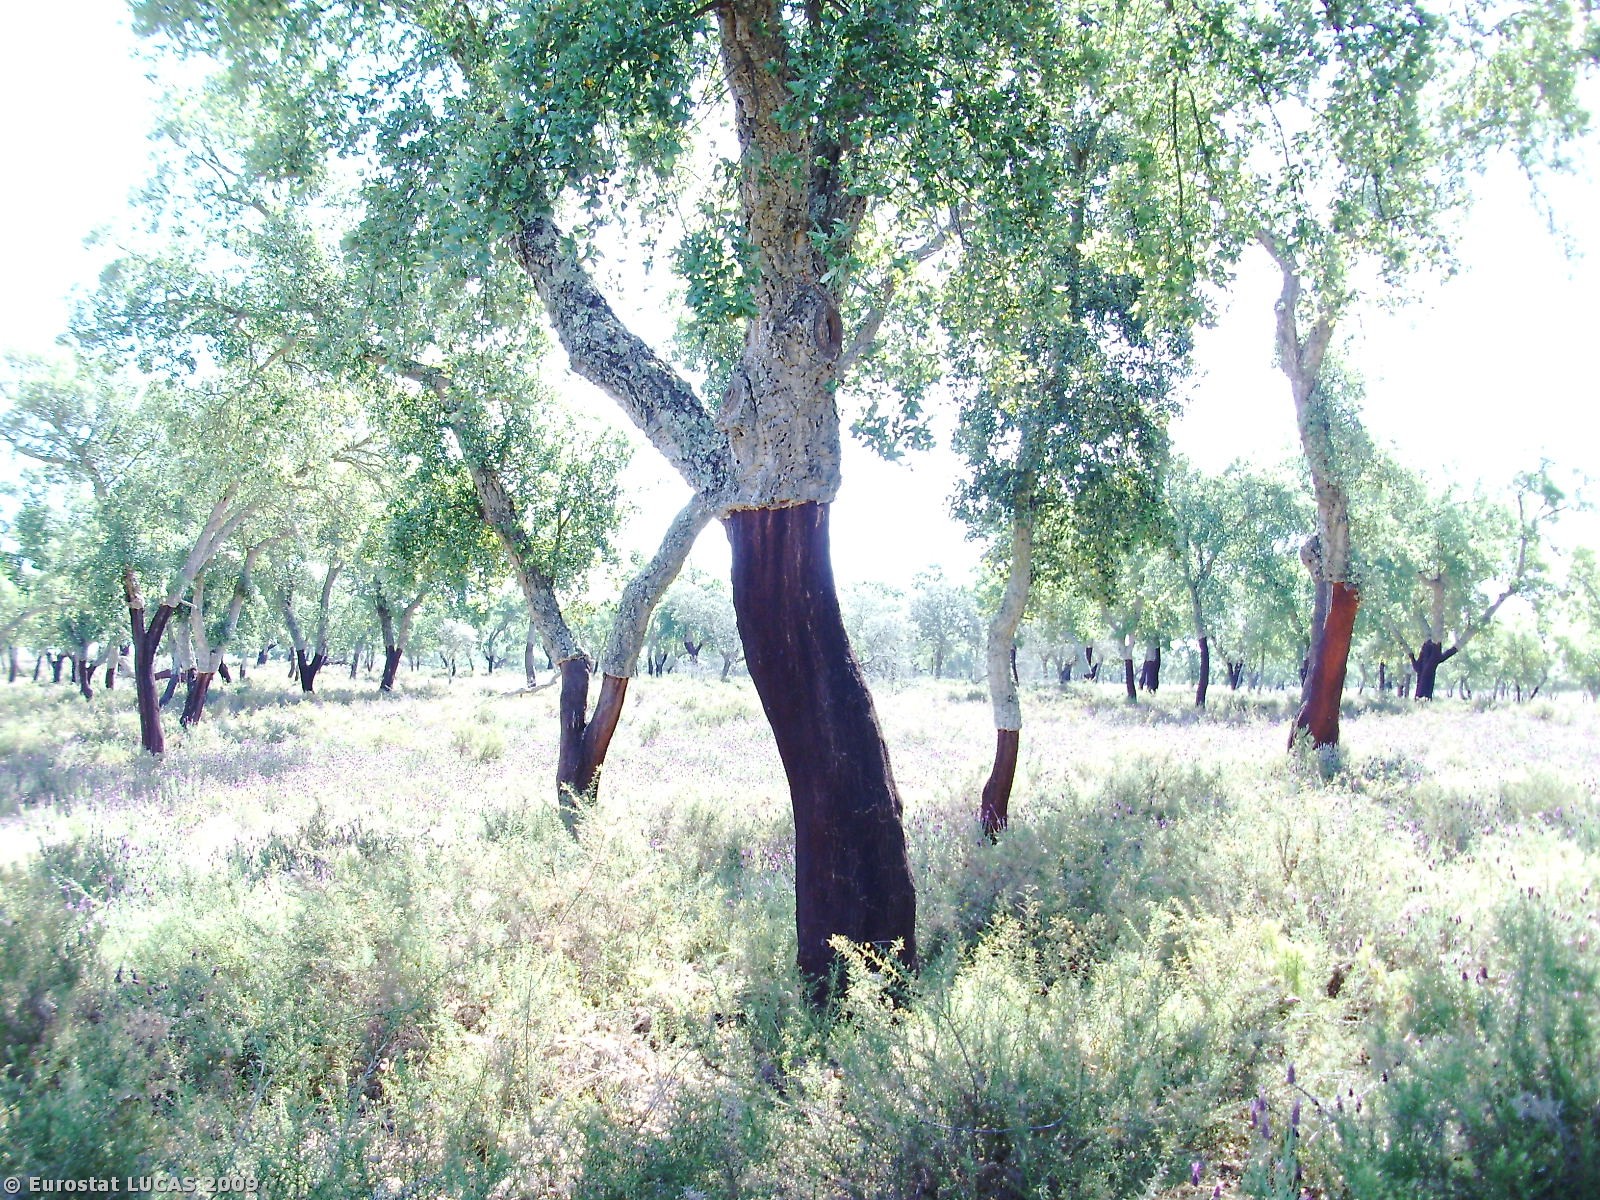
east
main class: Woodland
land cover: Broadleaved woodland
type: broadleaved evergreen forest
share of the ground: 50 - 75 %
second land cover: Shrubland with sparse tree cover
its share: 25 - 50 %
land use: Forestry
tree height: > 5 m
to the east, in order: Broadleaved woodland; Shrubland with sparse tree cover; Broadleaved woodland; Spontaneously vegetated surfaces
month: May
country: PT
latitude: 39.1941
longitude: -7.9169
